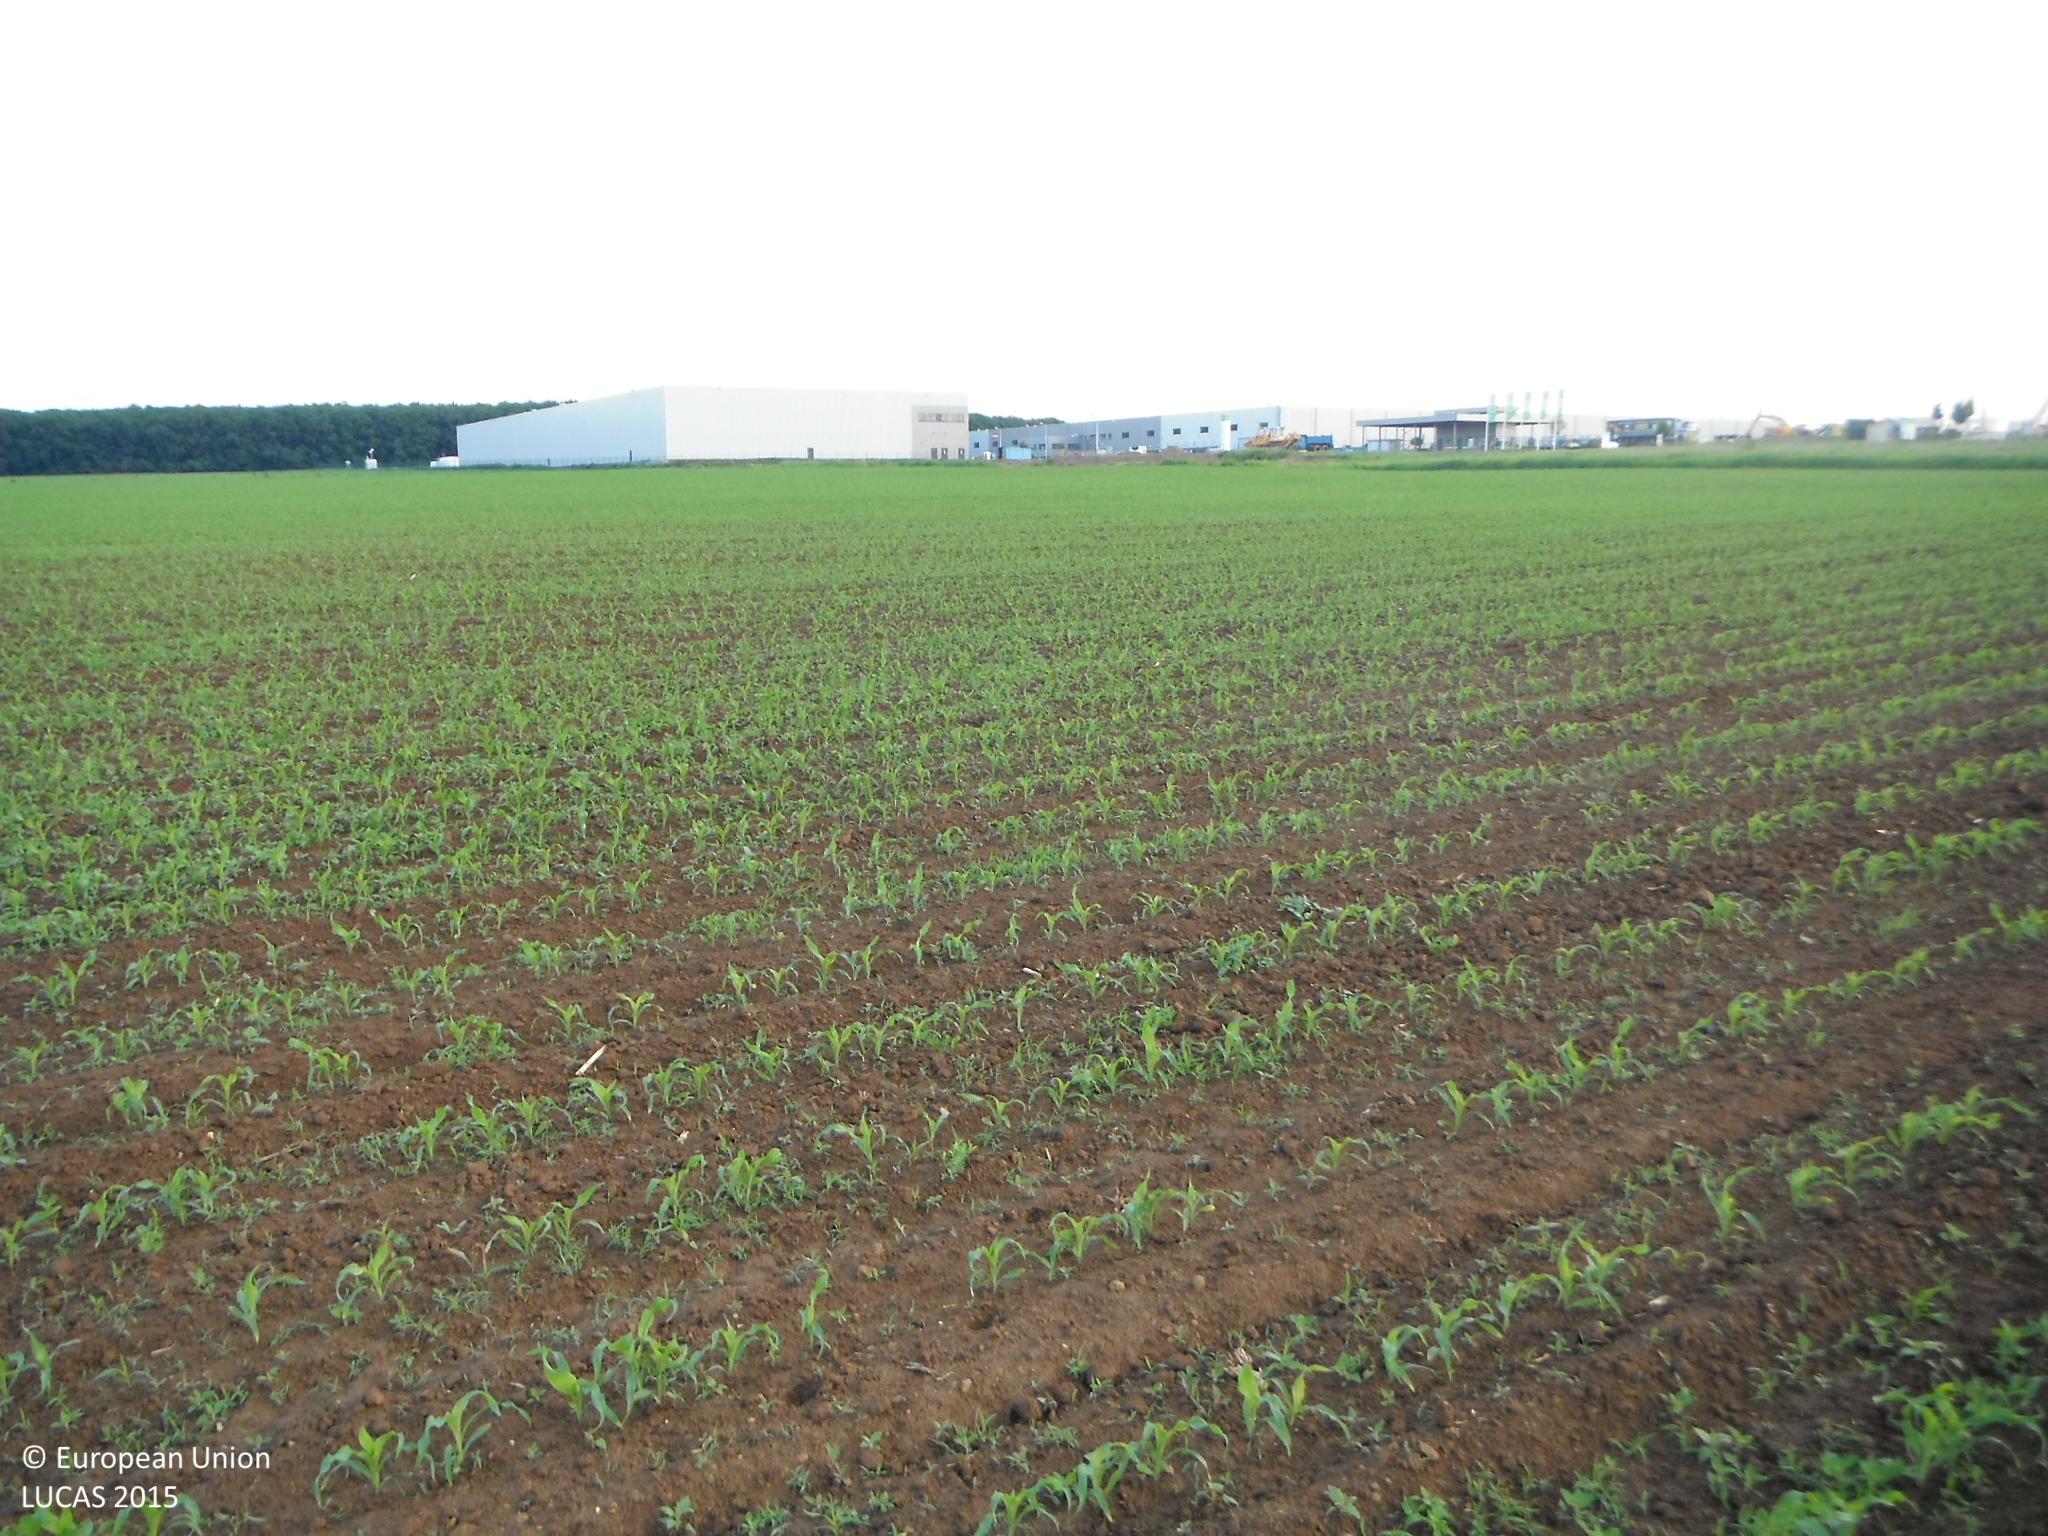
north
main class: Cropland
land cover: Maize
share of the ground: 25 - 50 %
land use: Agriculture (excluding fallow land and kitchen gardens)
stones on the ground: < 10 %
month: May
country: SK
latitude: 48.2491
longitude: 17.3491
